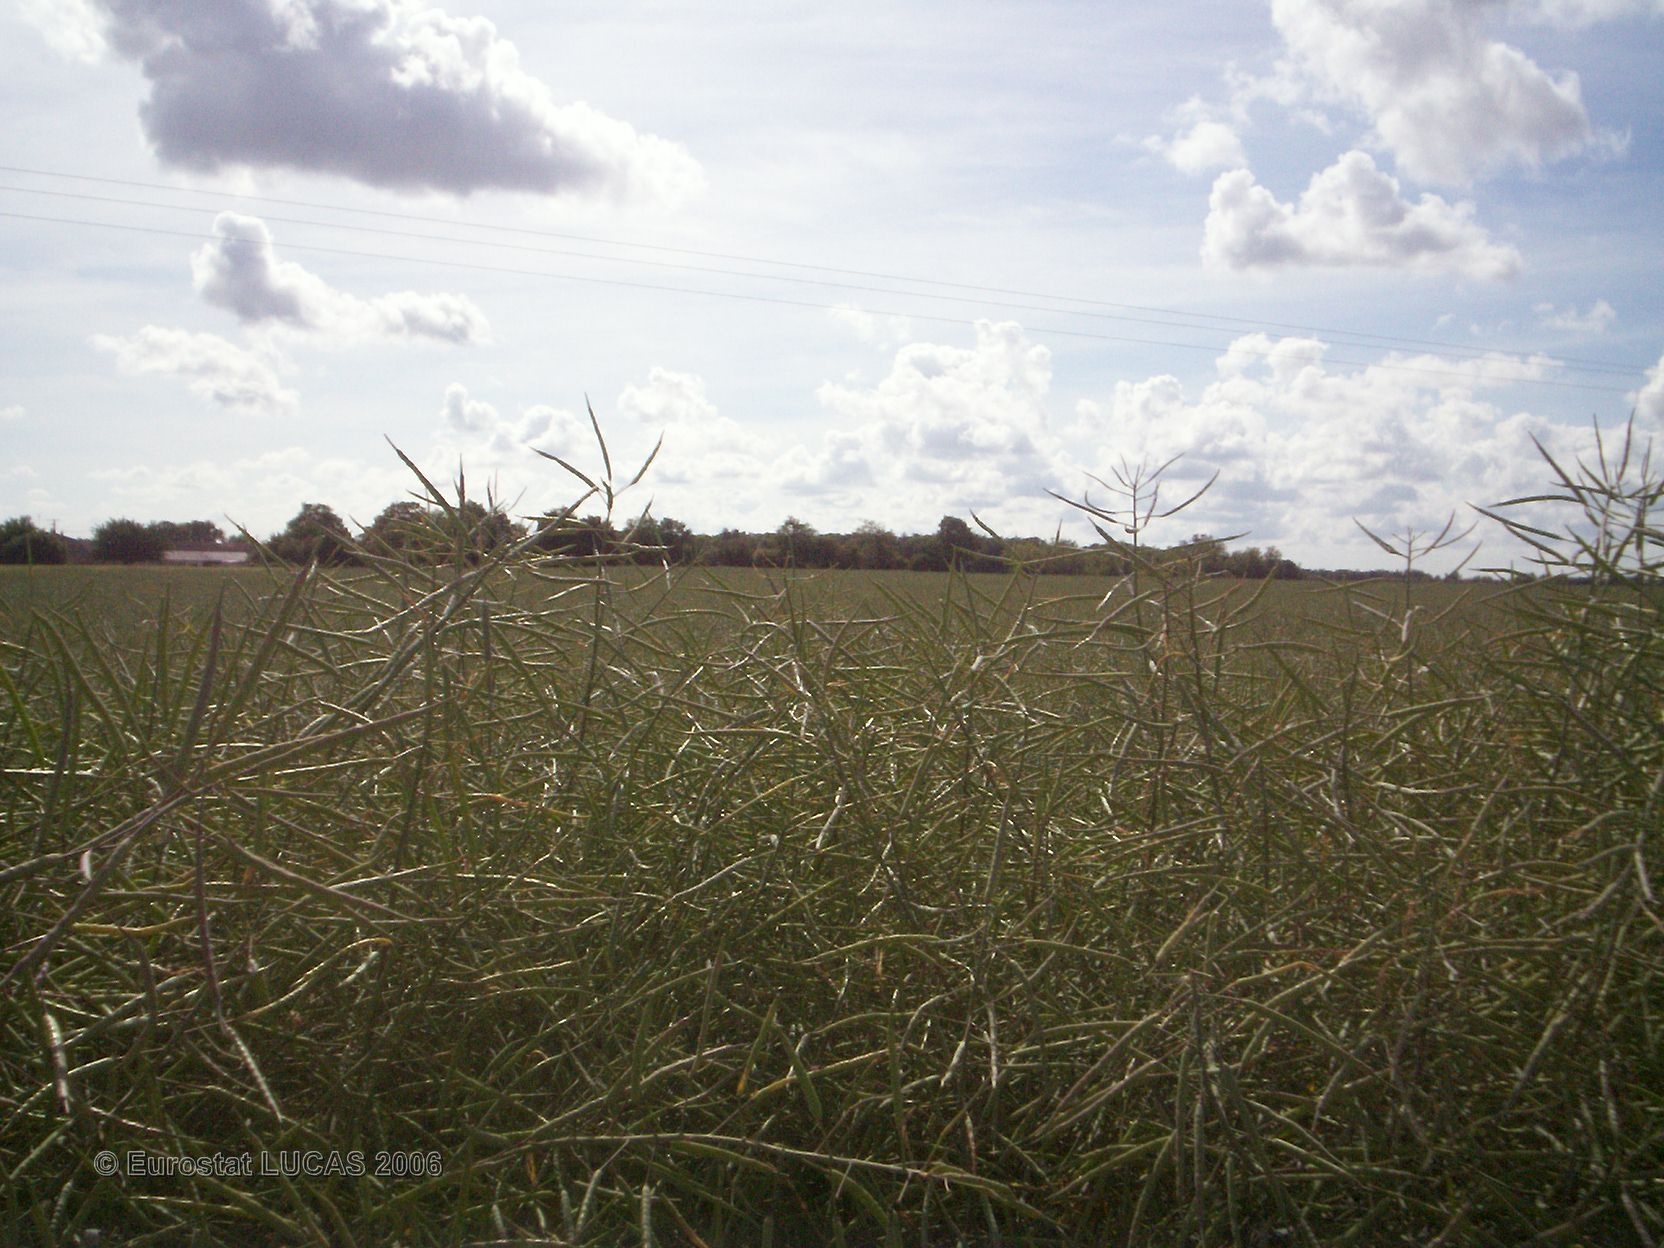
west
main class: Cropland
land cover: Rape and turnip rape
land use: Agriculture (excluding fallow land and kitchen gardens)
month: May
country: FR
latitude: 45.6607
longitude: -0.7673
